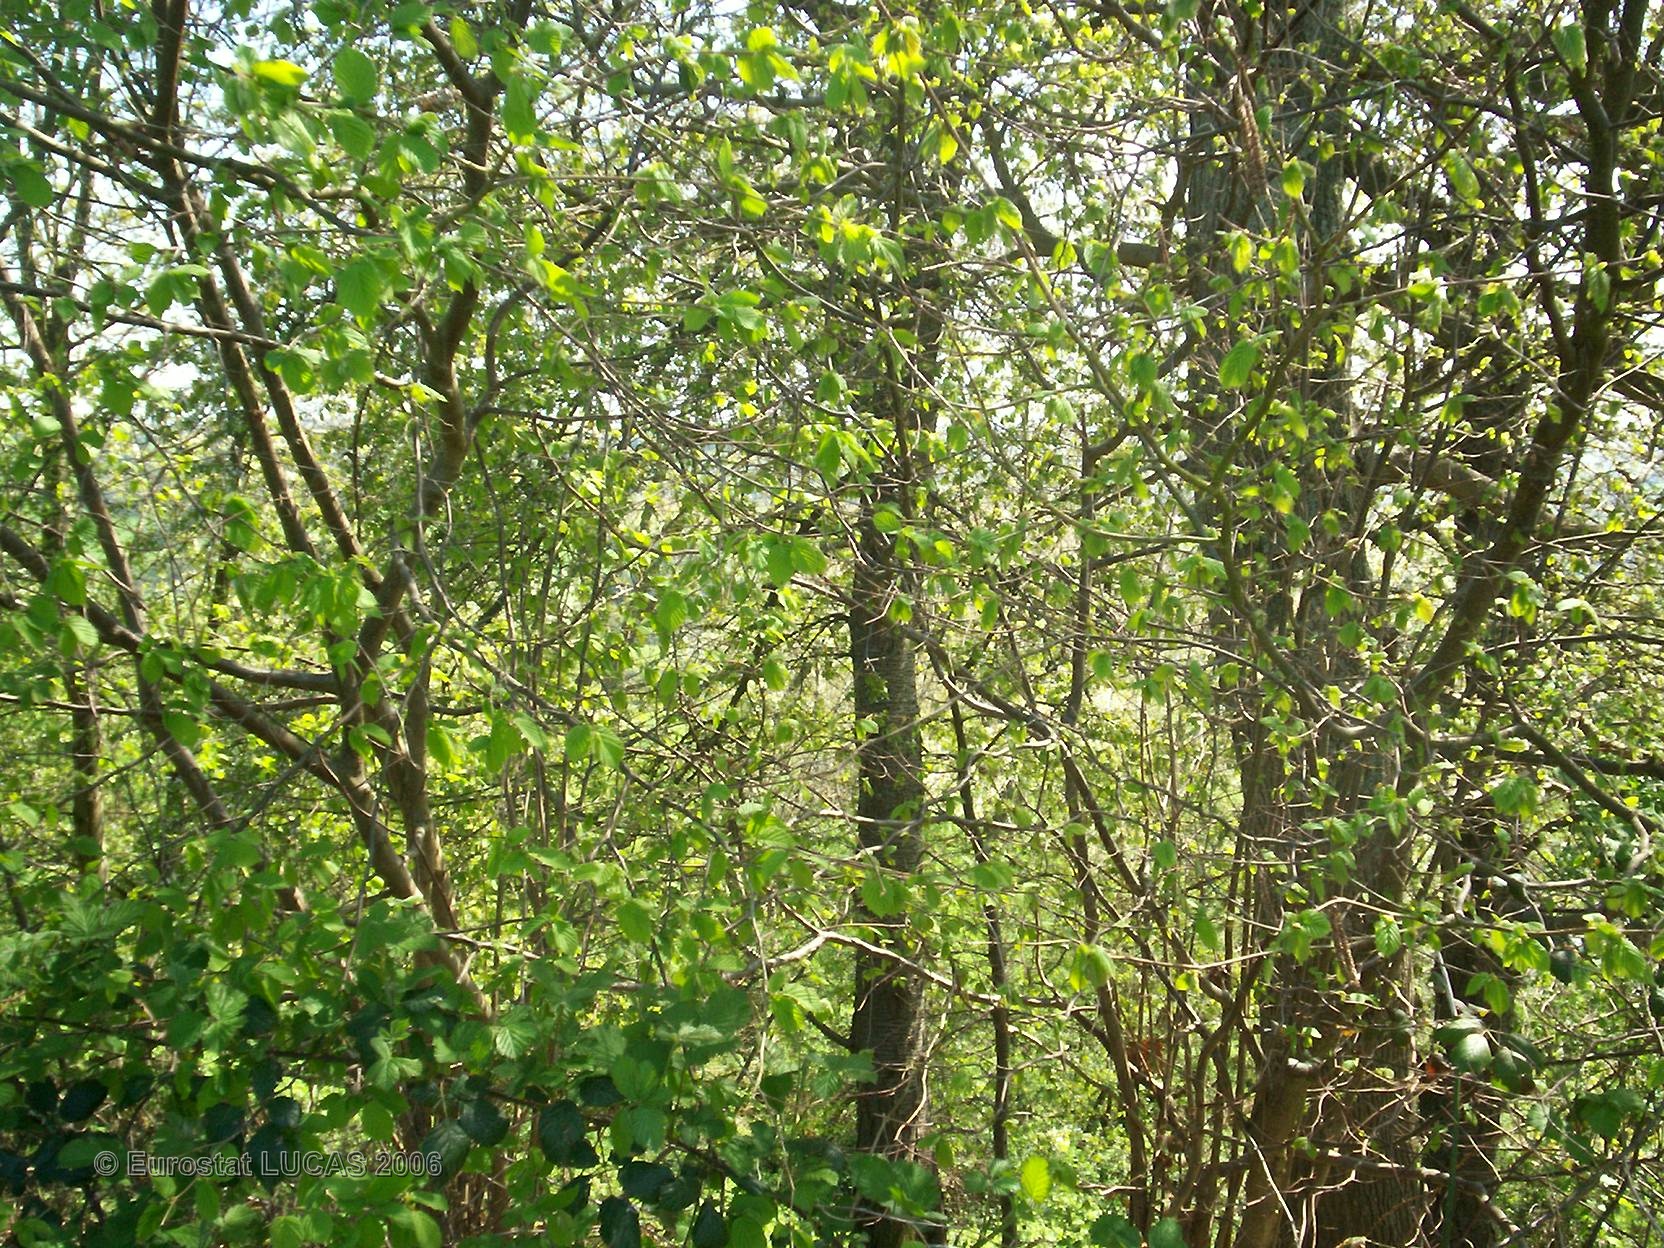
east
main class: Grassland
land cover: Grassland without tree/shrub cover
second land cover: Grassland with sparse tree/shrub cover
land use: Road transport
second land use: Agriculture (excluding fallow land and kitchen gardens)
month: April
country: FR
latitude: 49.2500
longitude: -0.0466
